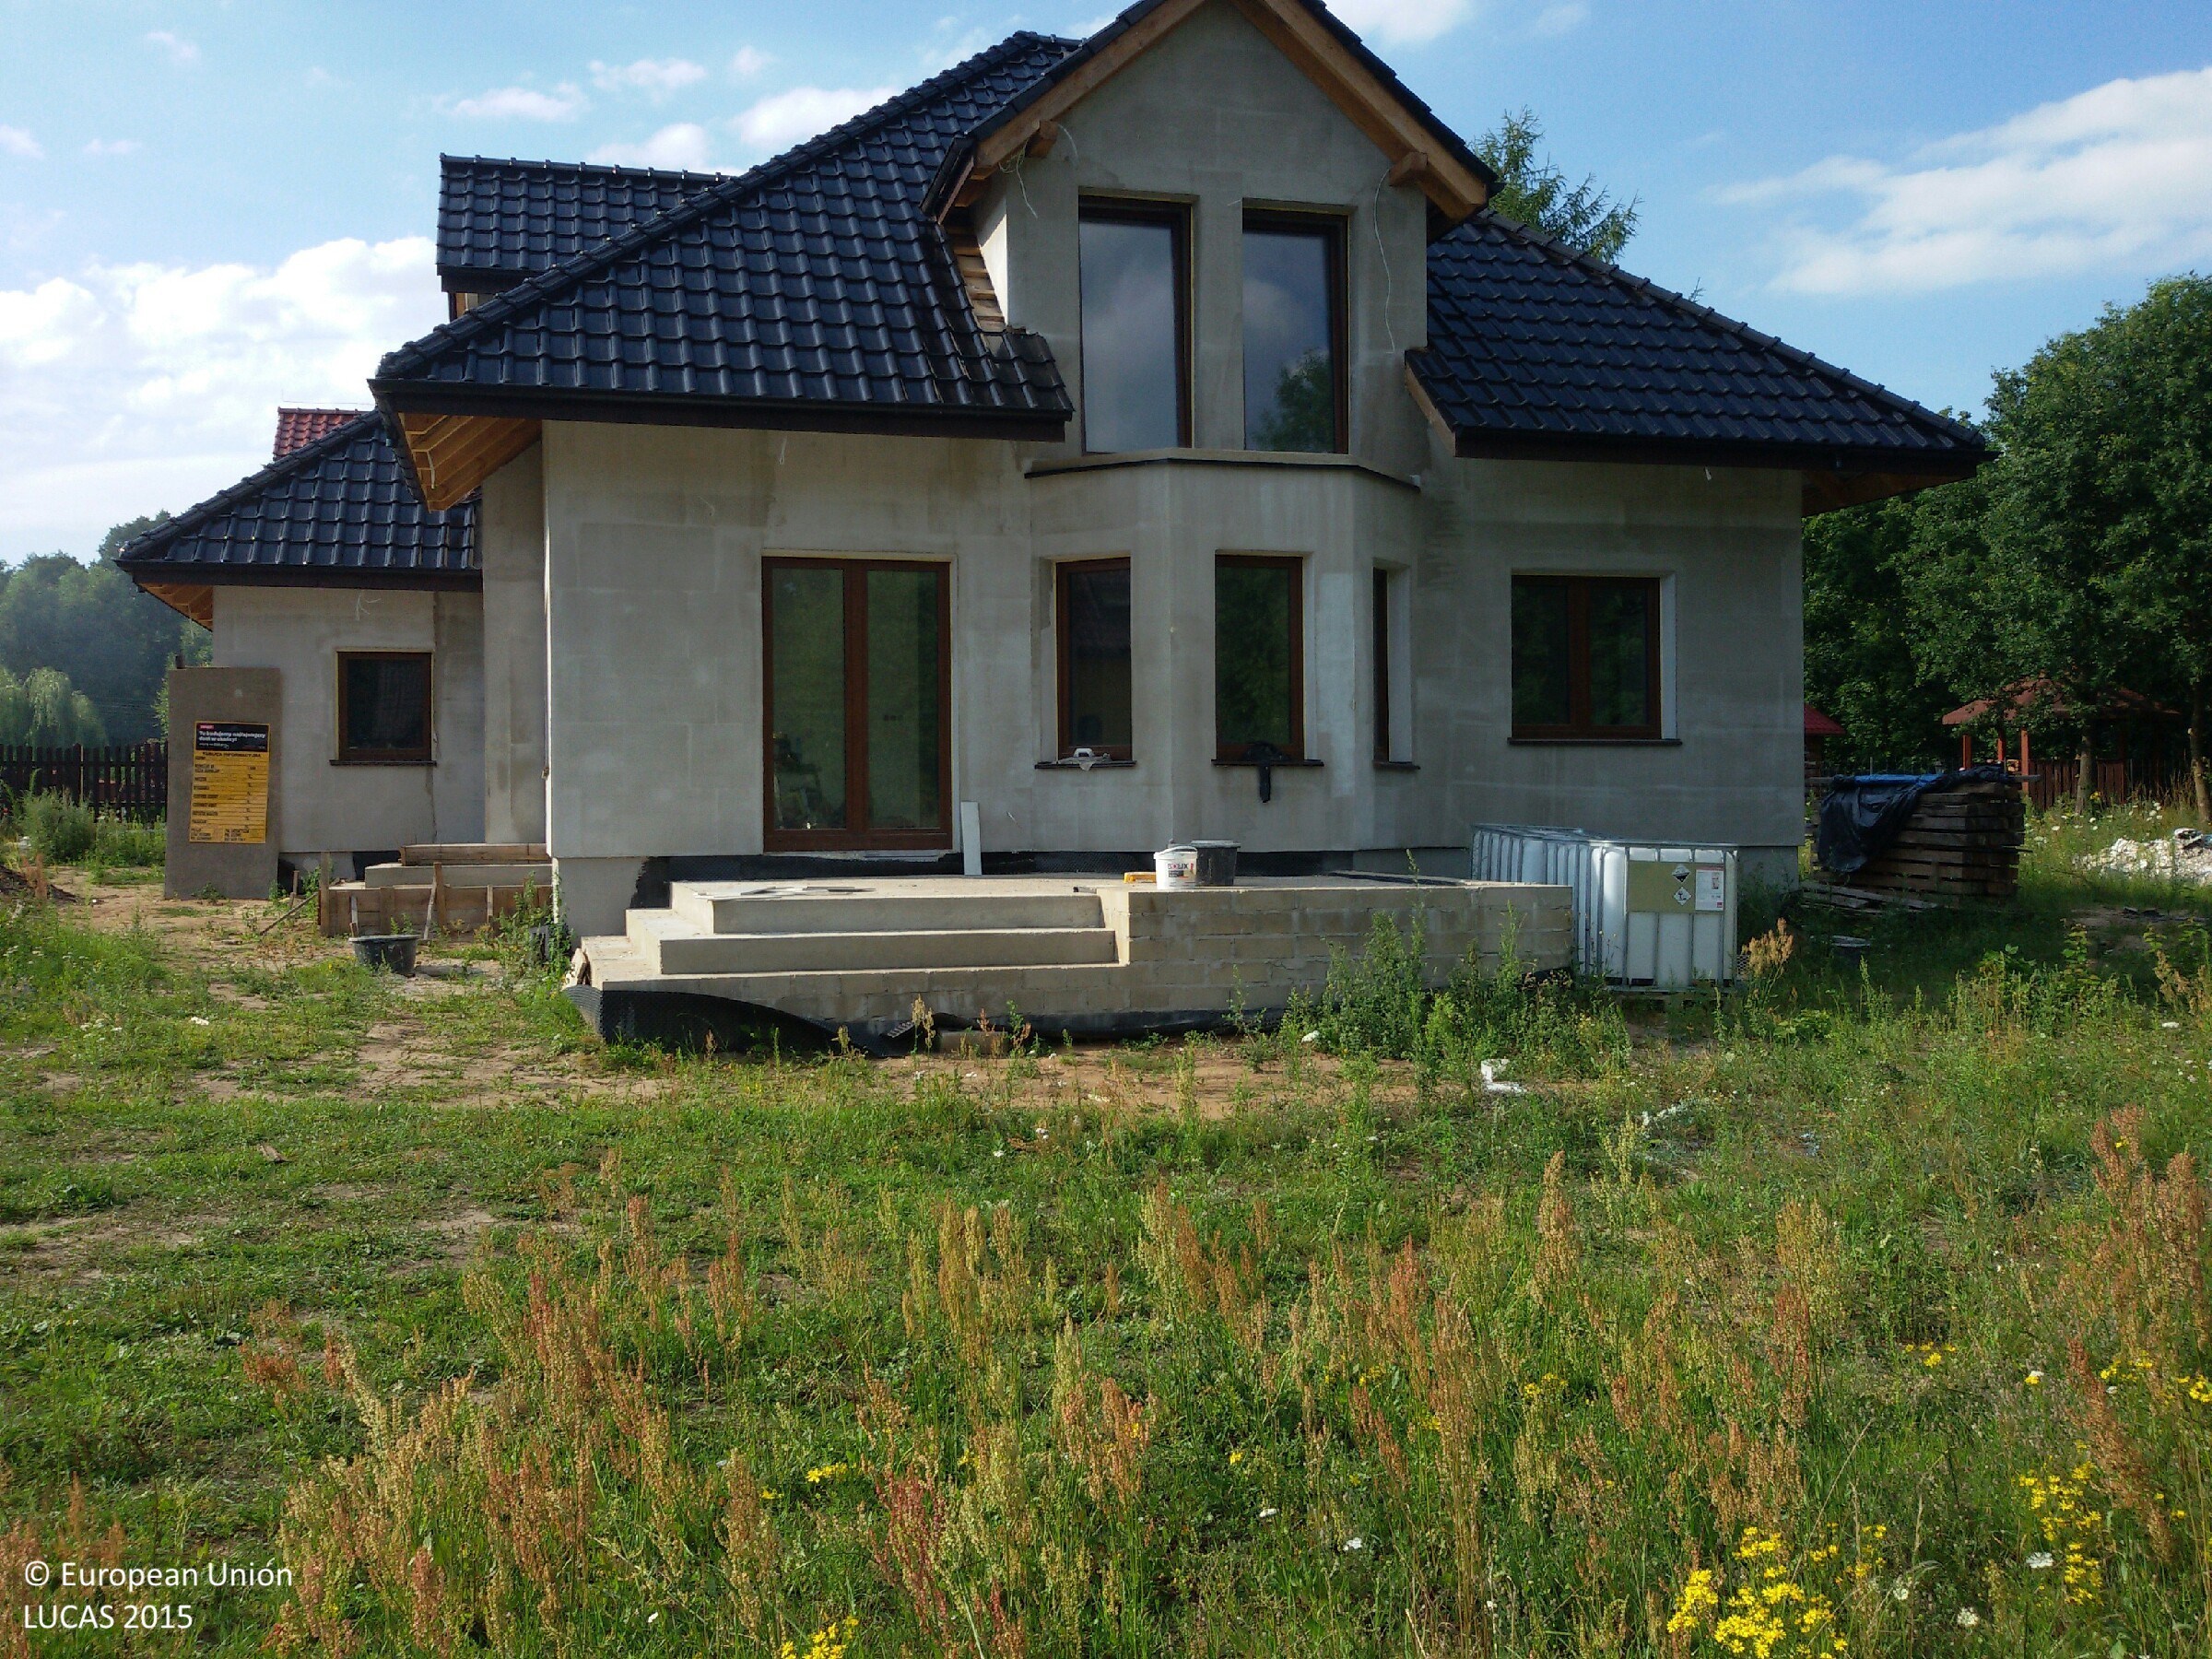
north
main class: Grassland
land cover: Spontaneously vegetated surfaces
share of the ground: > 75 %
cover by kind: herbaceous plants 100 %
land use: Construction
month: July
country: PL
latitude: 53.2118
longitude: 15.7393
